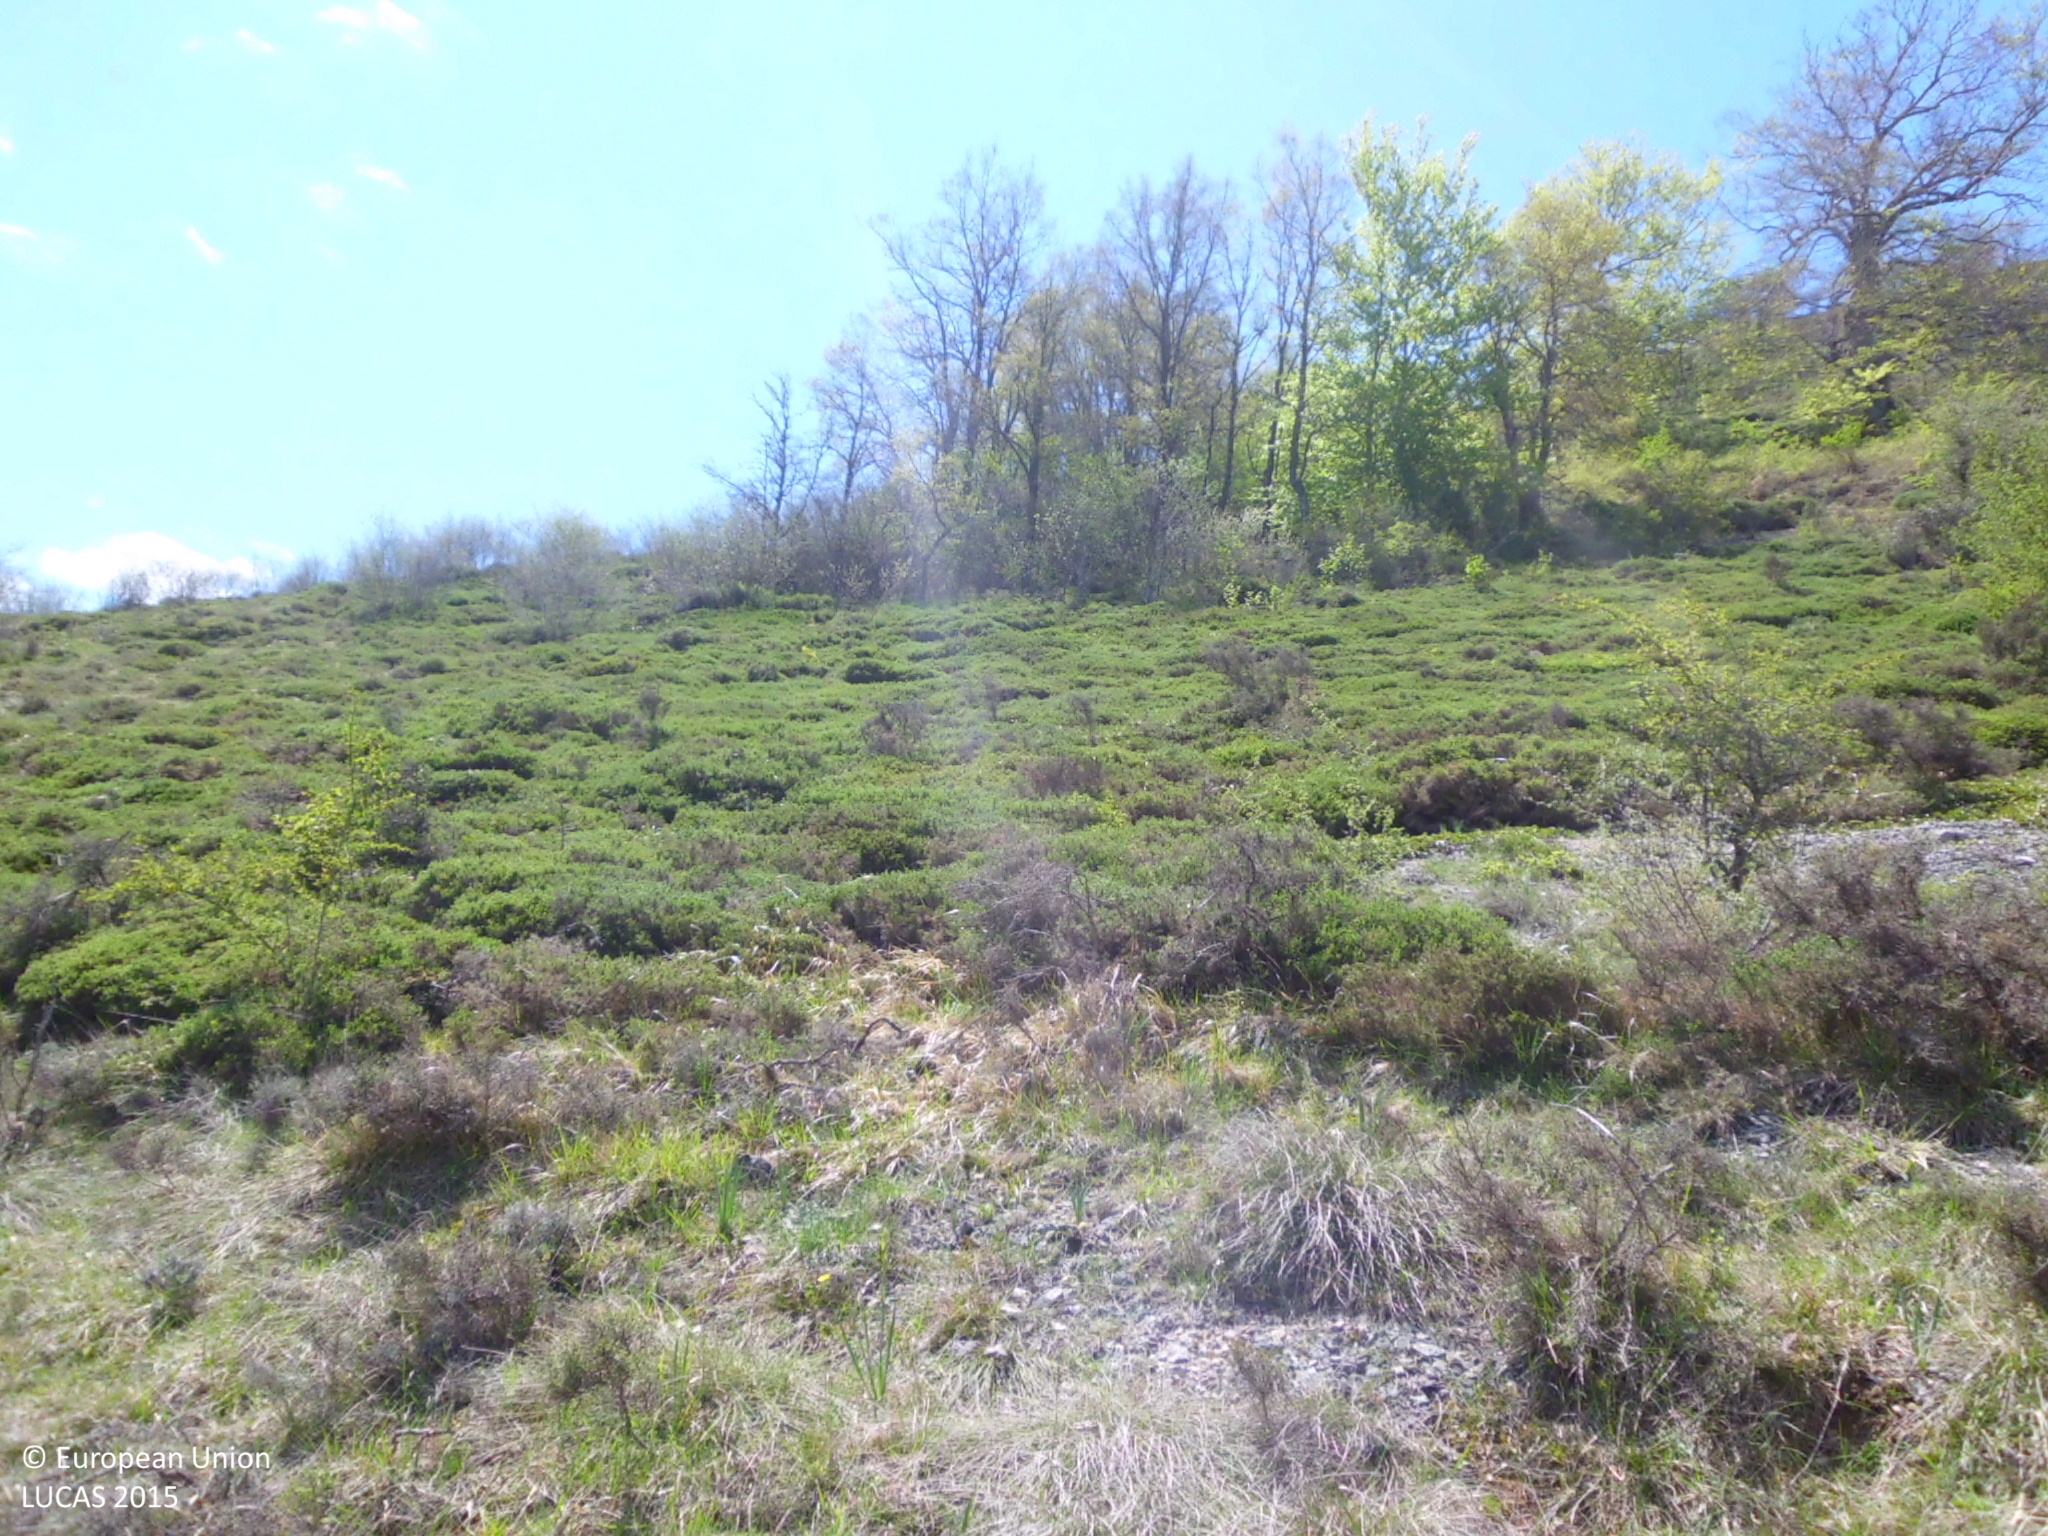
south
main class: Shrubland
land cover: Shrubland without tree cover
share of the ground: 25 - 50 %
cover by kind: herbaceous plants 60 %, shrubs 40 %
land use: Semi-natural and natural areas not in use
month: May
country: ES
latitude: 42.7522
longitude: -3.7620
